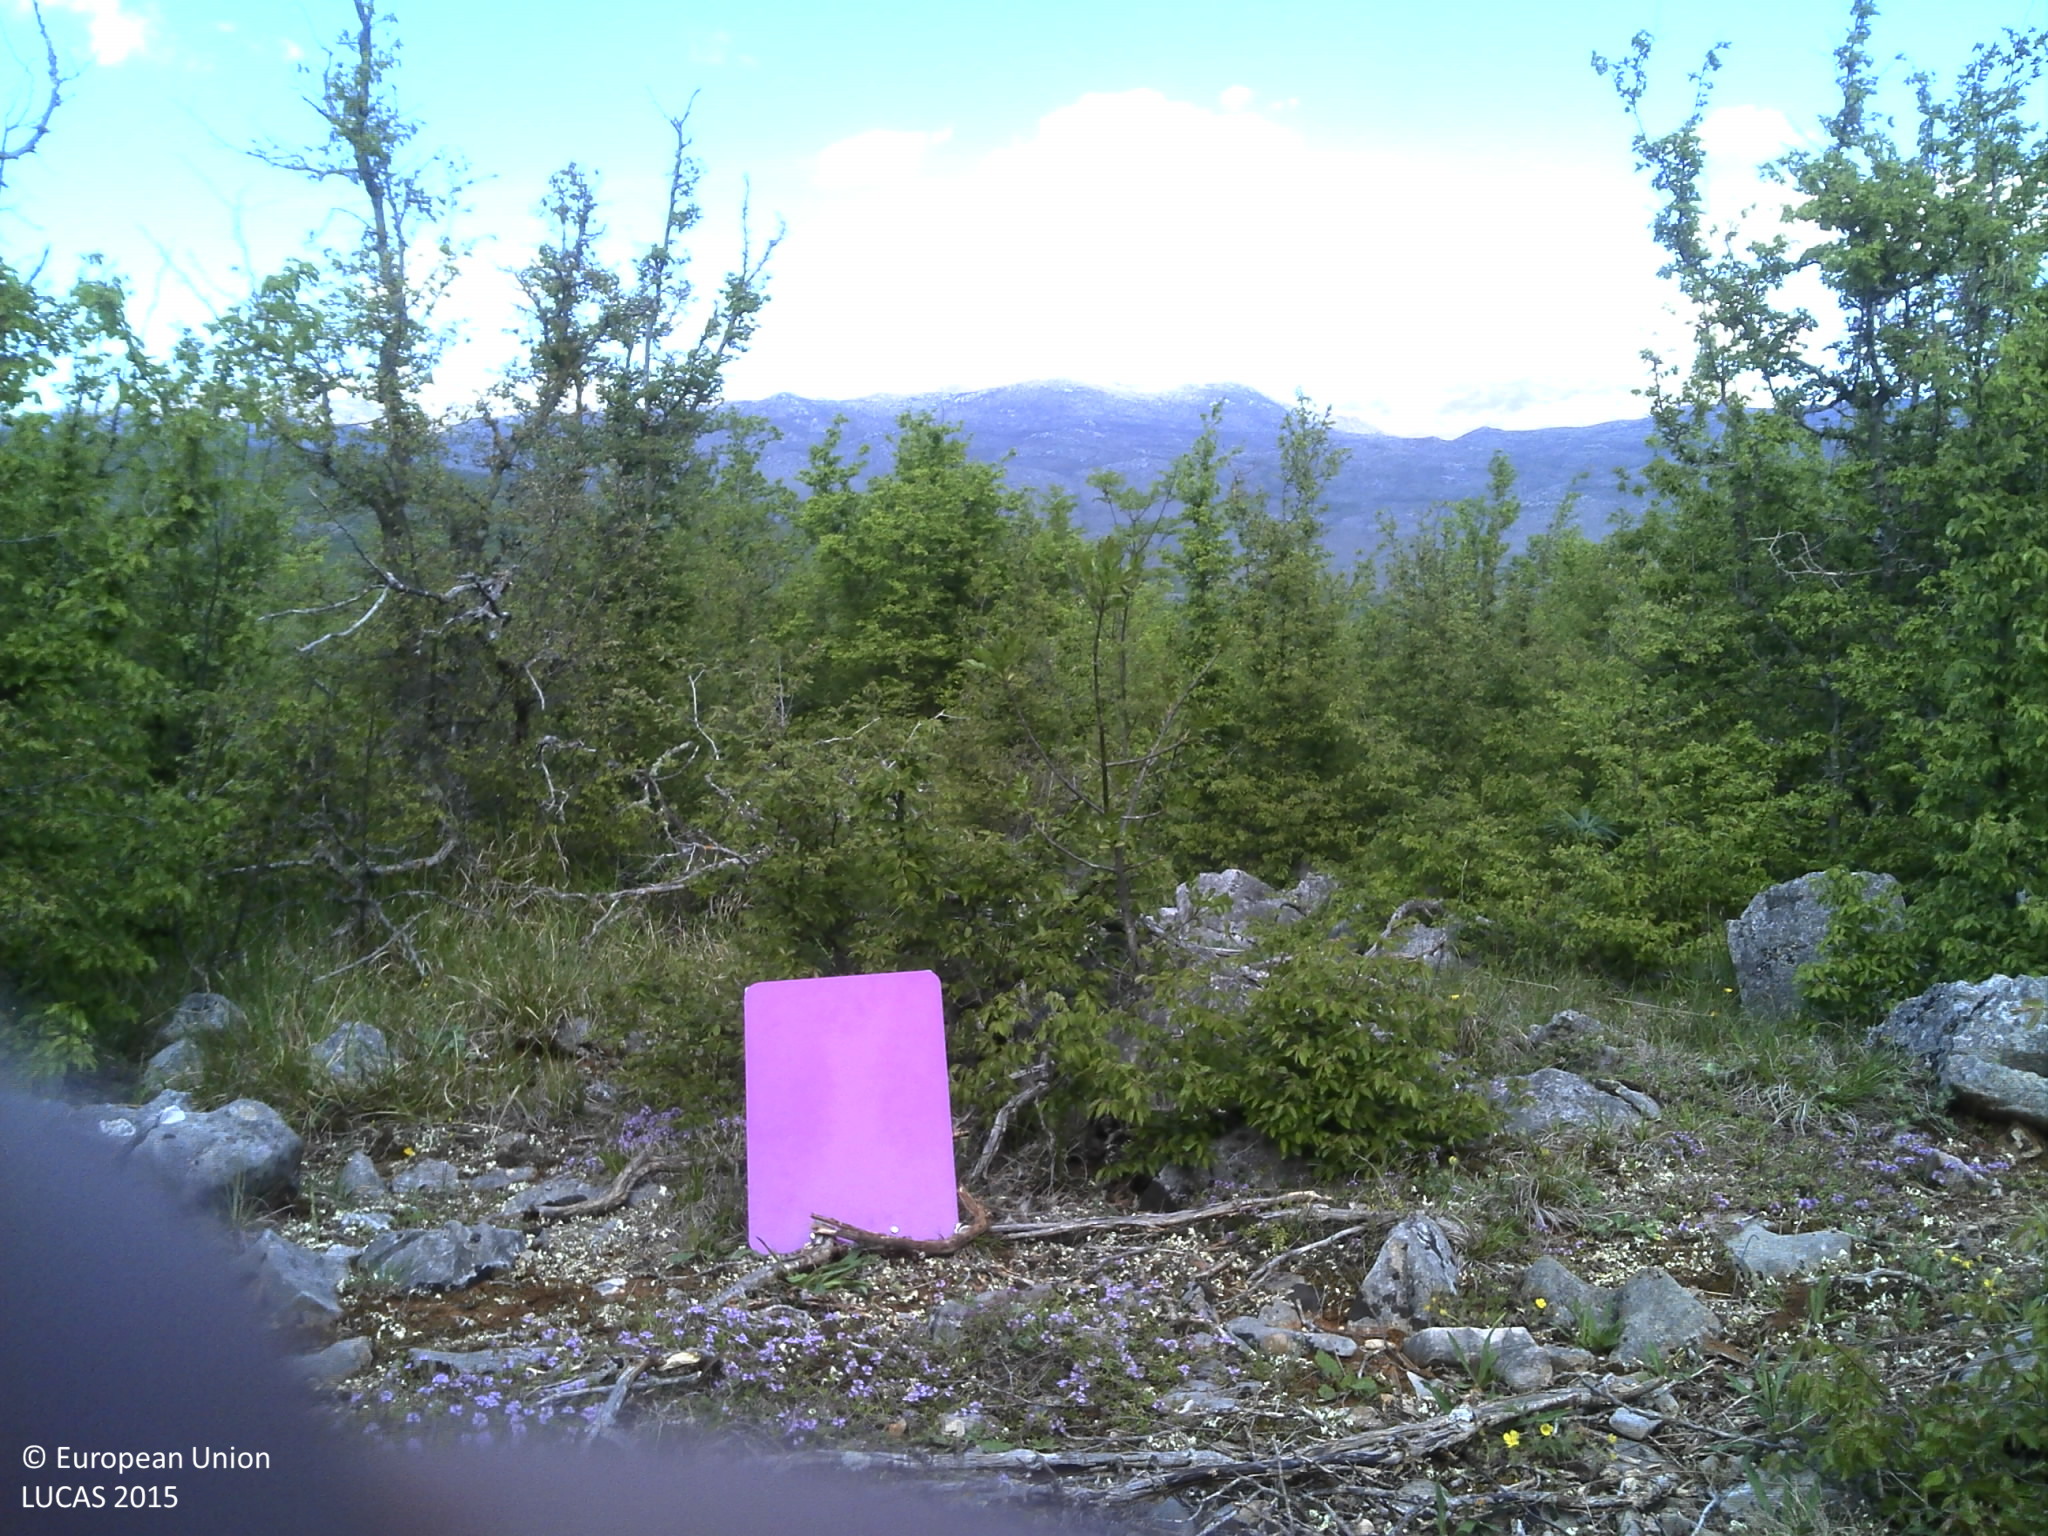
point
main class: Woodland
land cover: Broadleaved woodland
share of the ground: > 75 %
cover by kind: broadleaved forest trees 90 %, herbaceous plants 5 %, unconsolidated bare surface 5 %
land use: Semi-natural and natural areas not in use
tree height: < 5 m
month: April
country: HR
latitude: 44.1835
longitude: 15.8846
